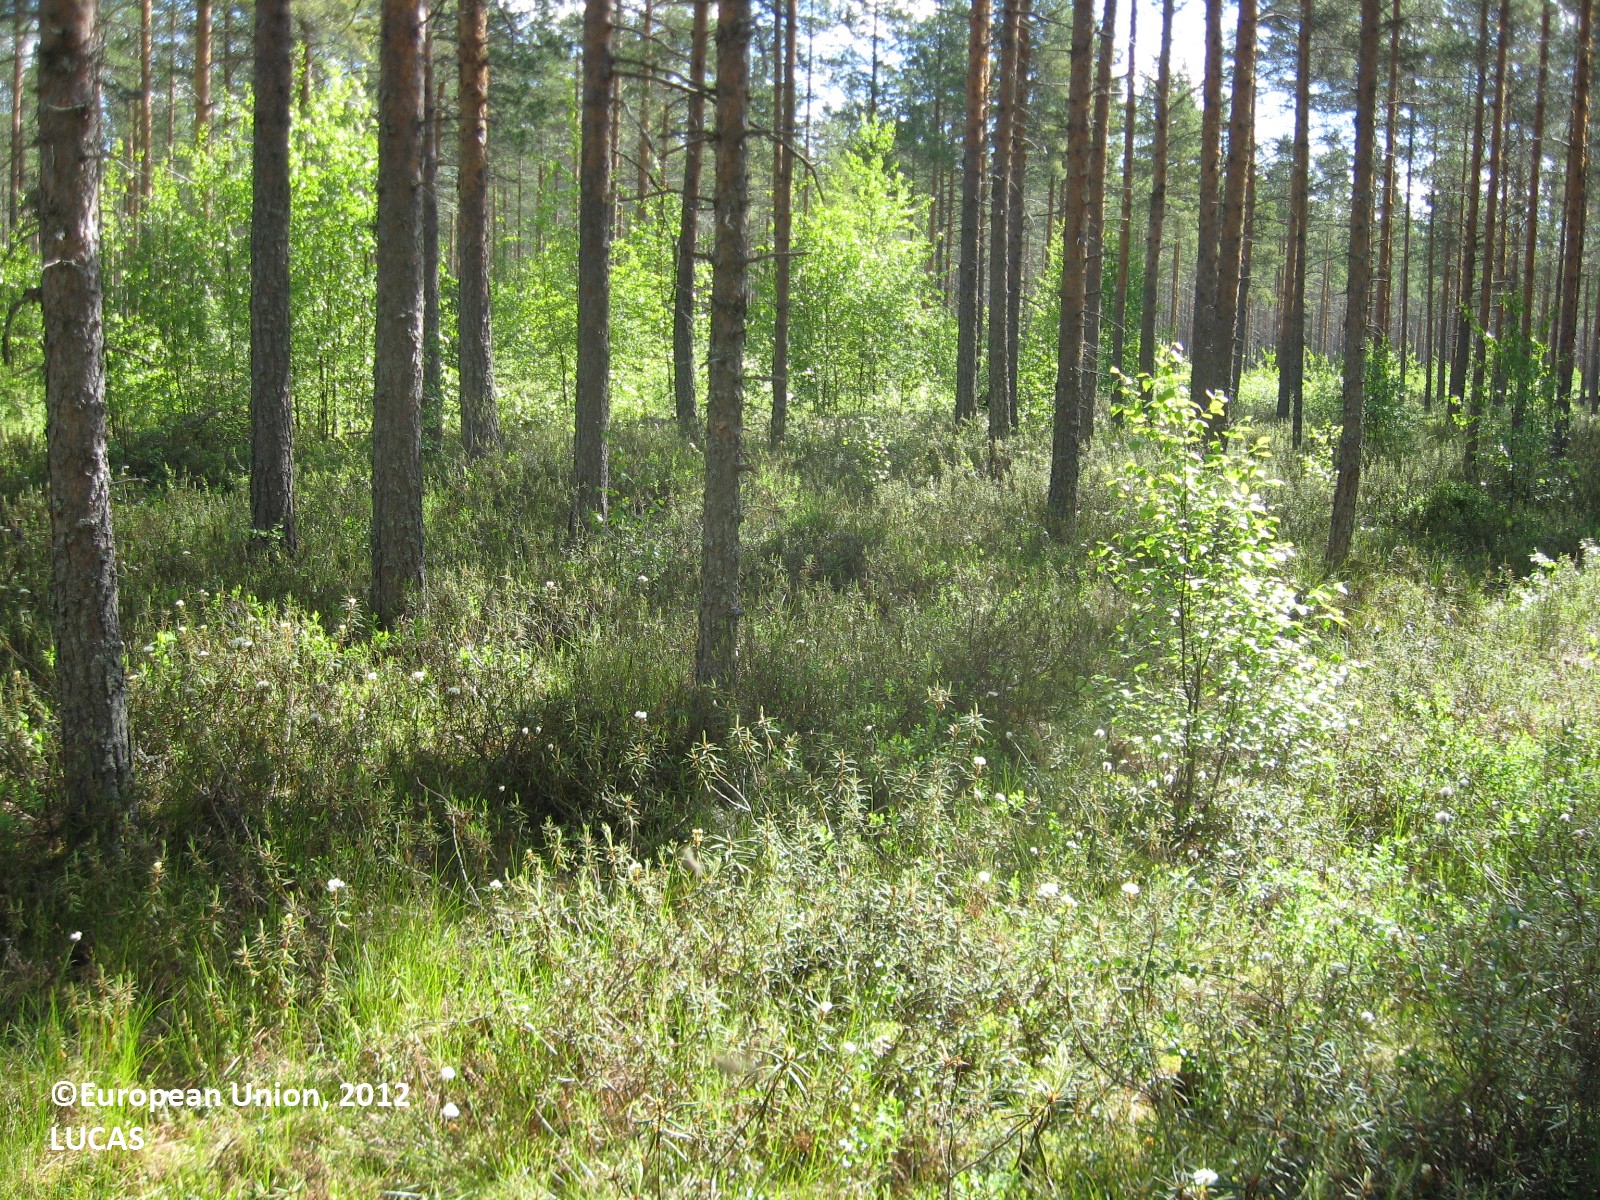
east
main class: Woodland
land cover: Pine dominated coniferous woodland
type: boreal forest
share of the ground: 50 - 75 %
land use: Forestry
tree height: > 5 m
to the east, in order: Pine dominated coniferous woodland; Ditches and canals; Pine dominated coniferous woodland
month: June
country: FI
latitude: 63.2058
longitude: 22.7187
